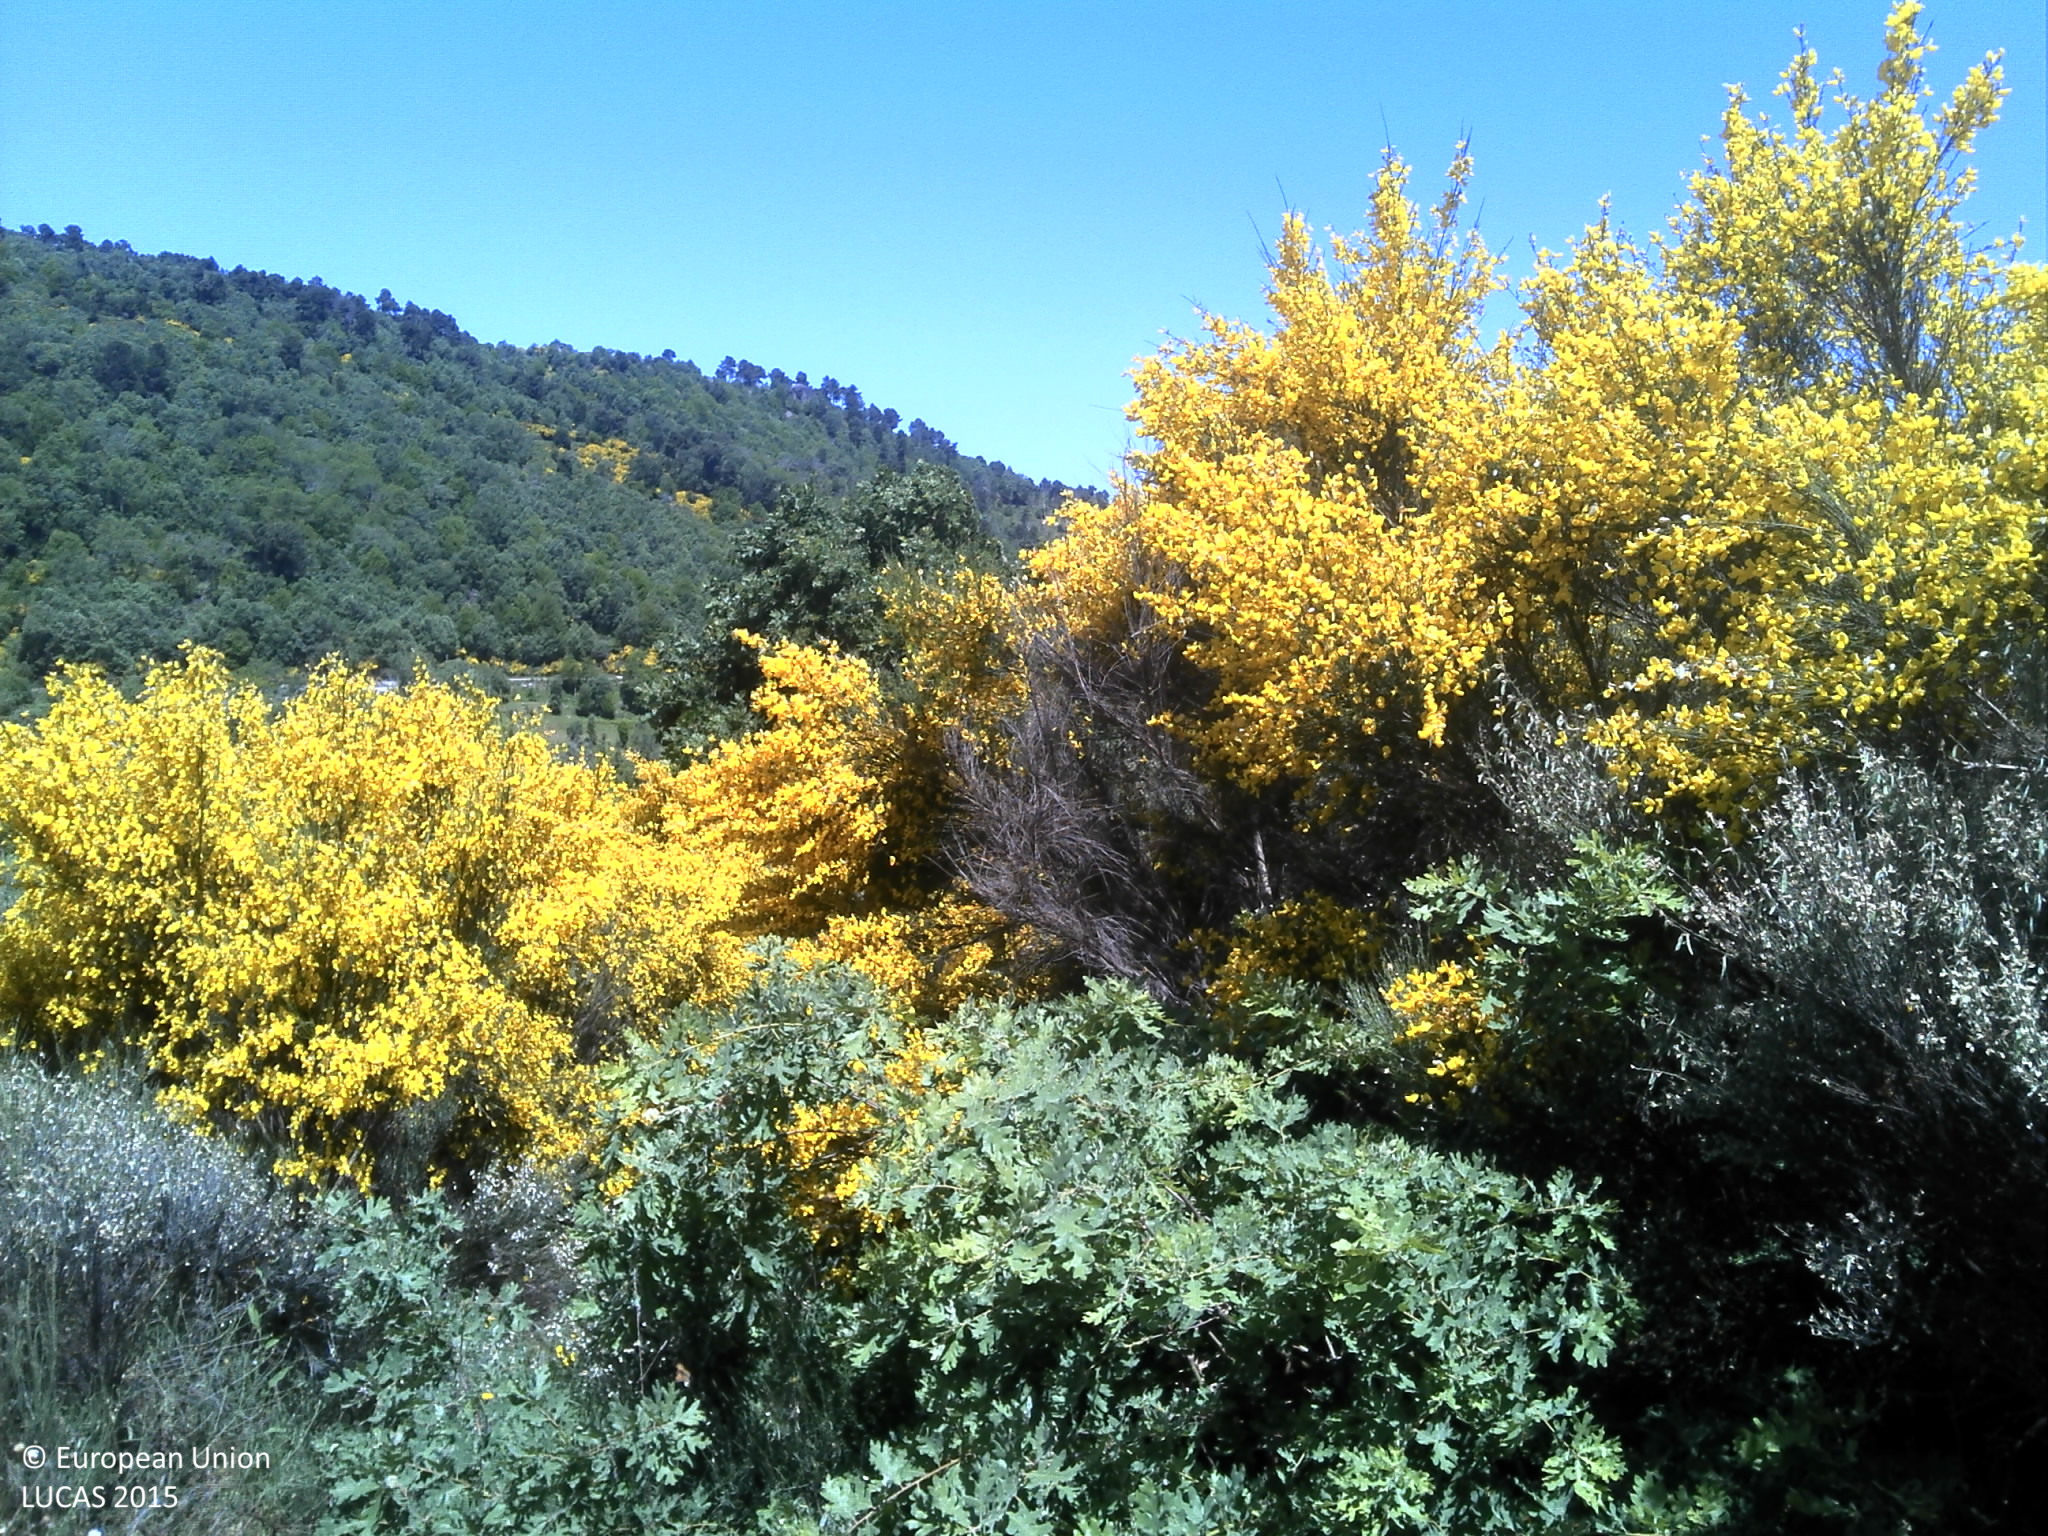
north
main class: Shrubland
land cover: Shrubland with sparse tree cover
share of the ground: > 75 %
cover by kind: shrubs 80 %, unconsolidated bare surface 10 %, broadleaved forest trees 5 %, herbaceous plants 5 %
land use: Semi-natural and natural areas not in use
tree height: > 5 m
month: May
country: PT
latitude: 40.4592
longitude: -7.3594
